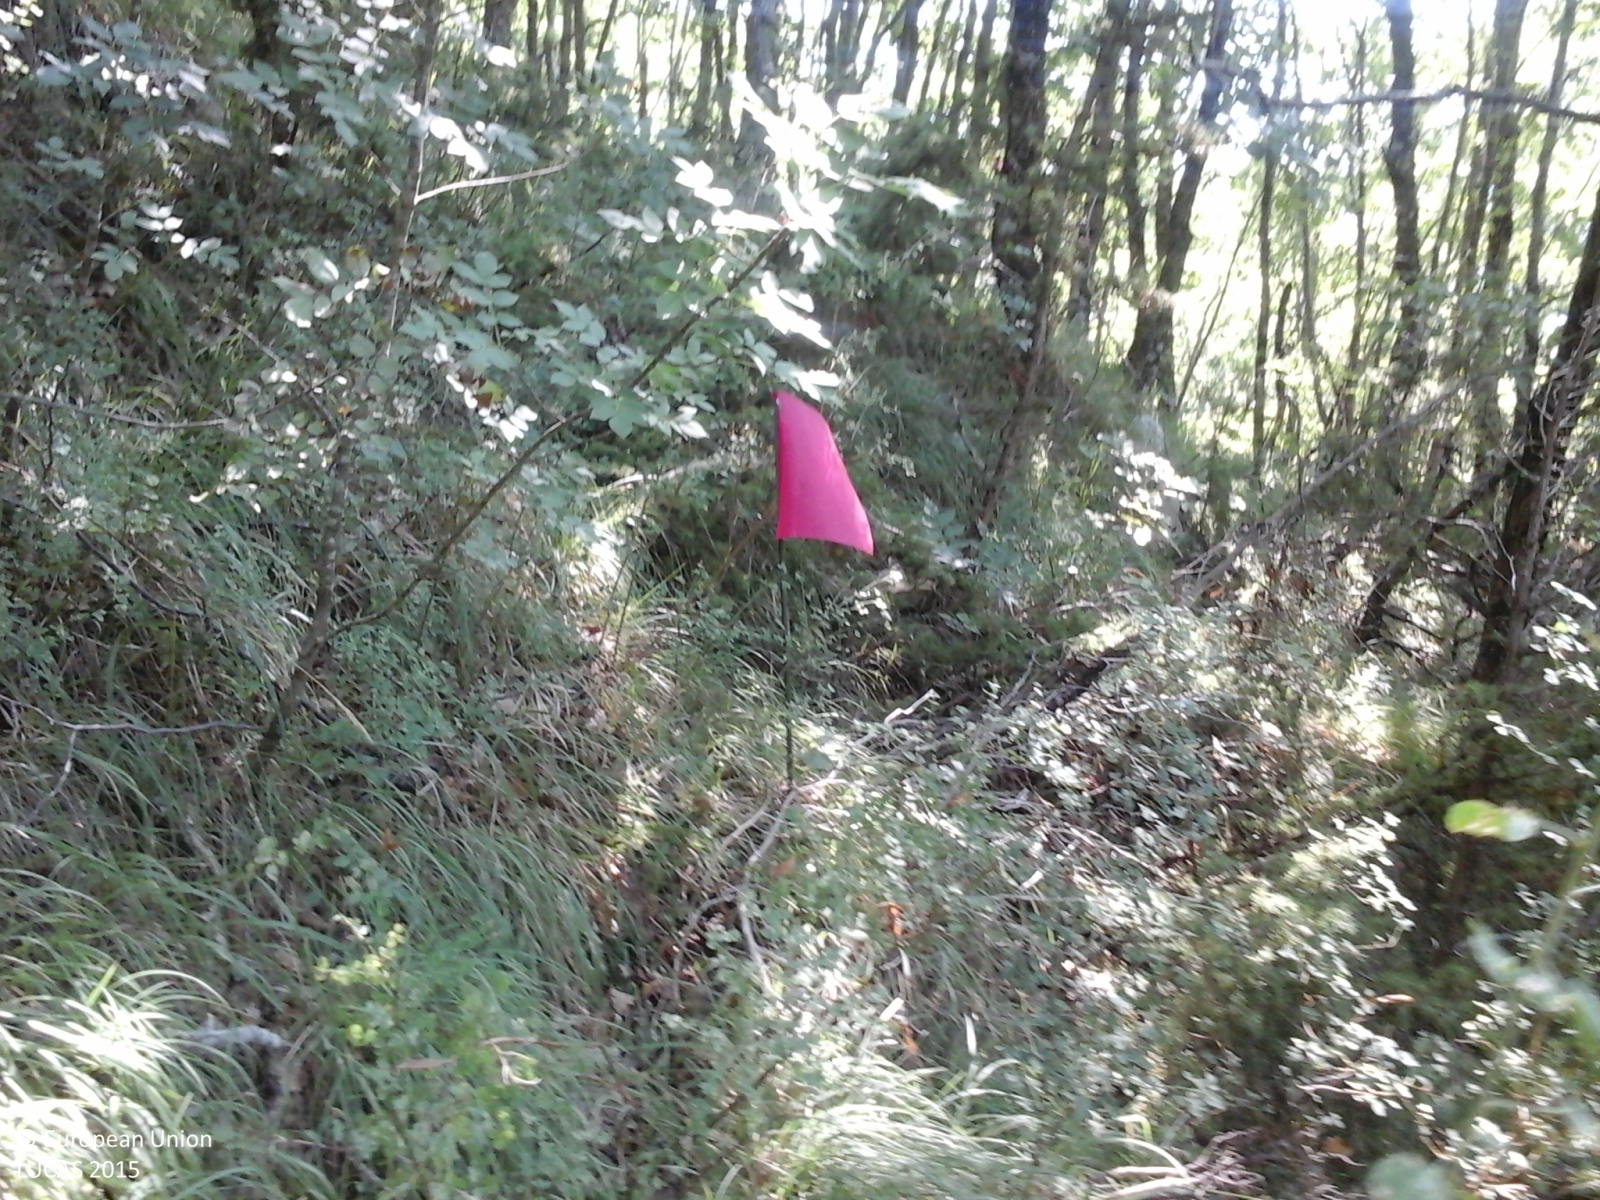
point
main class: Woodland
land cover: Broadleaved woodland
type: thermophilous deciduous forest
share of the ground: > 75 %
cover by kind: broadleaved forest trees 100 %
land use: Forestry
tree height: > 5 m
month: August
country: IT
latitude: 43.6953
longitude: 12.2153
